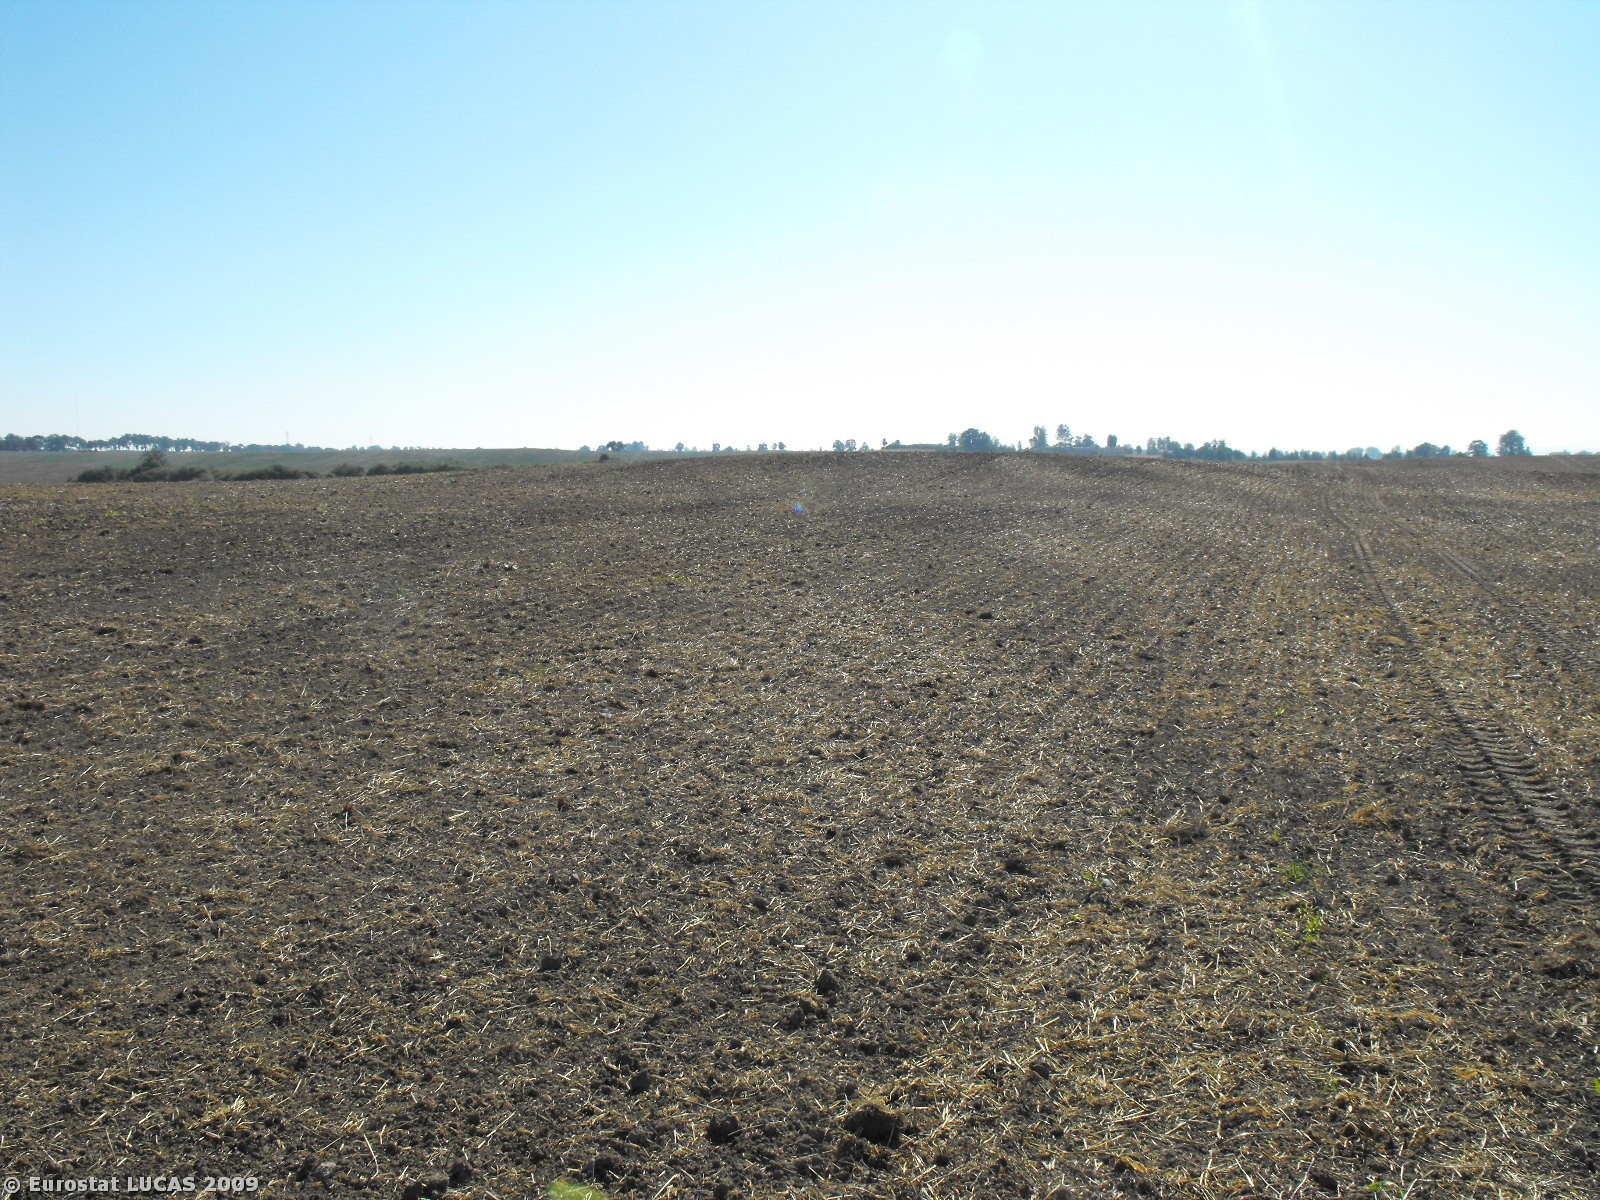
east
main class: Cropland
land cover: Barley
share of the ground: < 10 %
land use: Agriculture (excluding fallow land and kitchen gardens)
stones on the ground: < 10 %
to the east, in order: Barley
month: September
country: PL
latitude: 53.1708
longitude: 16.5447
